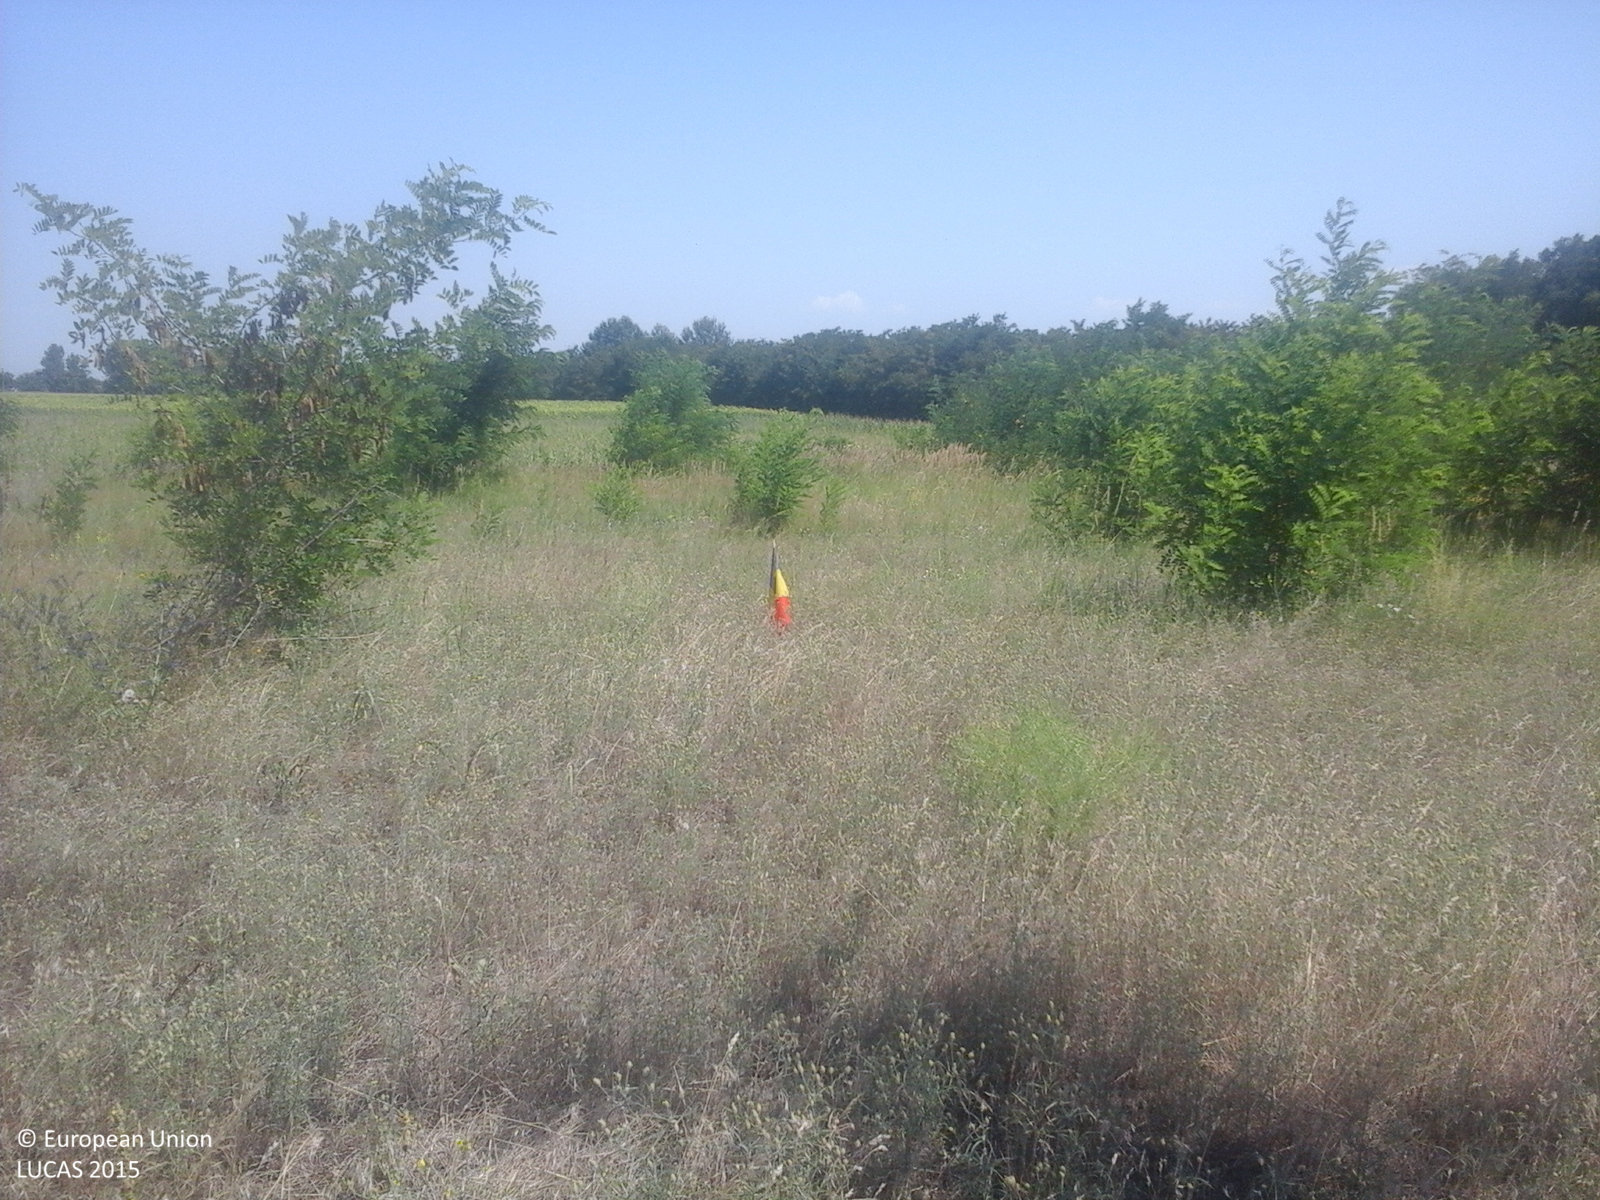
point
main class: Grassland
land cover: Grassland with sparse tree/shrub cover
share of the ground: > 75 %
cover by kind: herbaceous plants 85 %, shrubs 10 %, broadleaved forest trees 5 %
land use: Agriculture (excluding fallow land and kitchen gardens)
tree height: < 5 m
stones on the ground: < 10 %
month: July
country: RO
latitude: 44.8589
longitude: 27.7052
